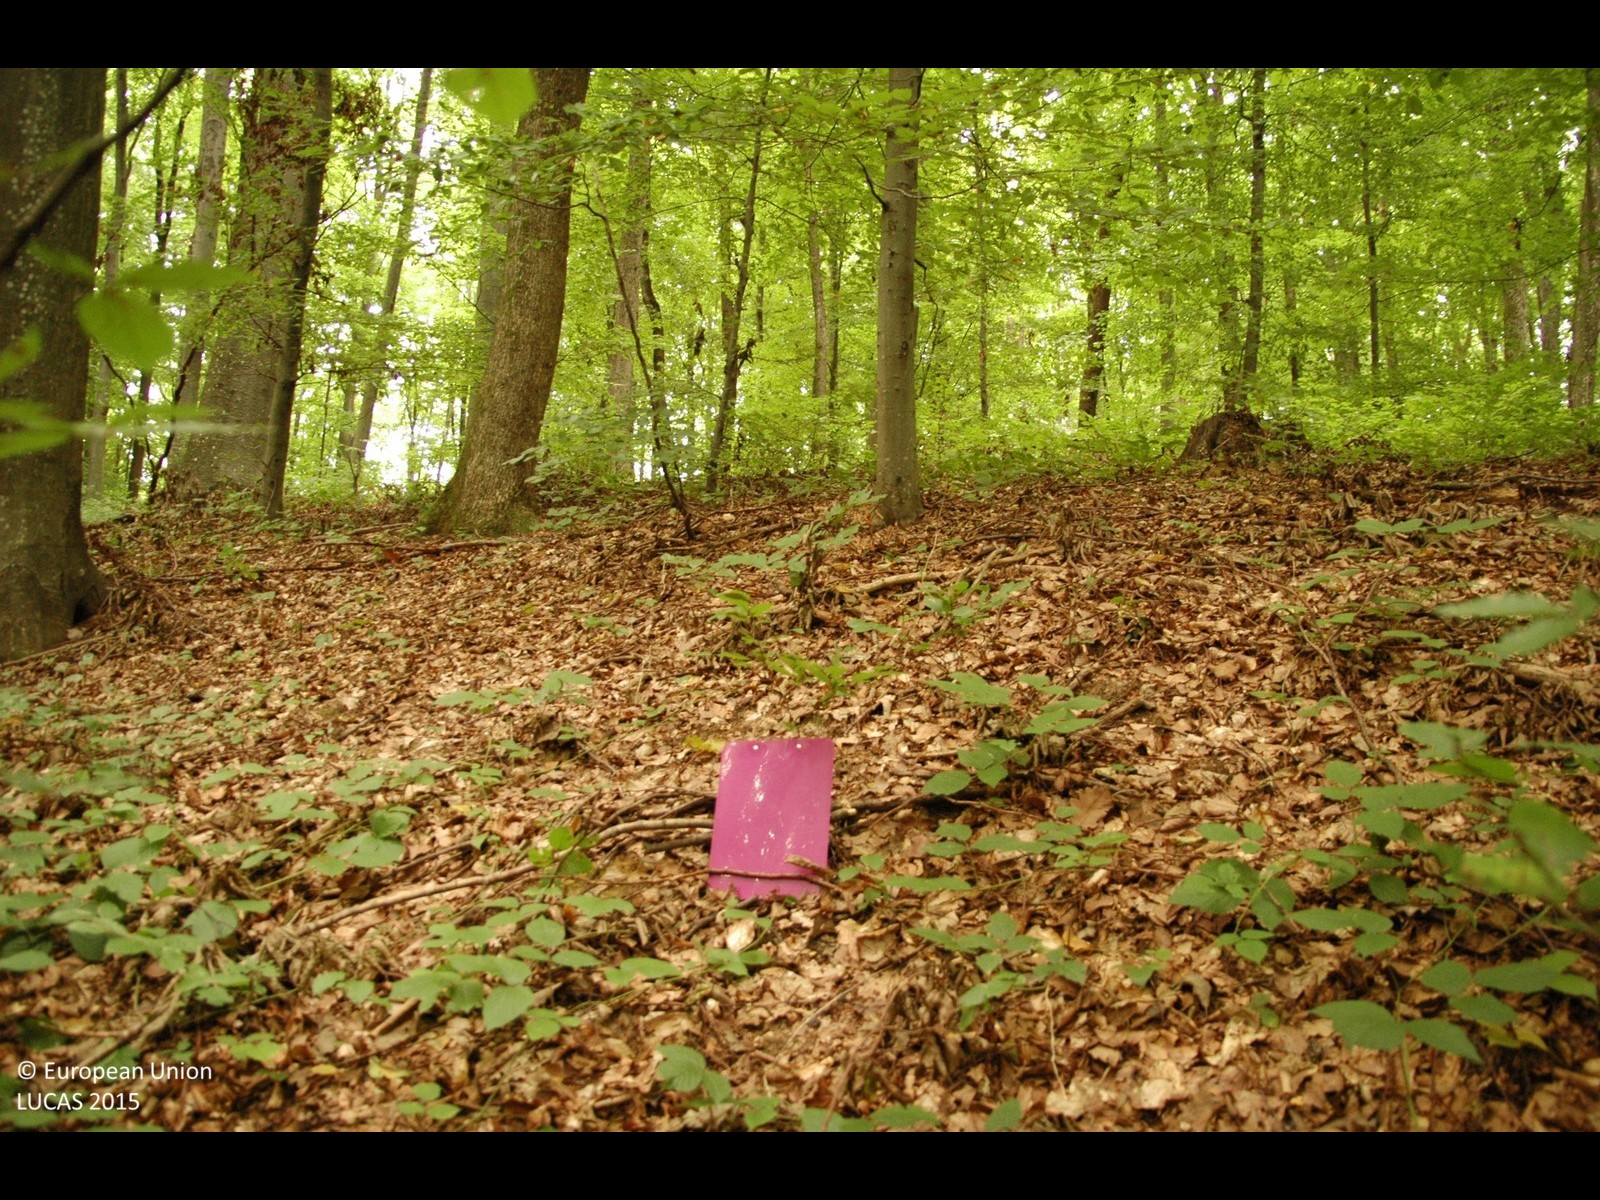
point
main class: Woodland
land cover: Broadleaved woodland
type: beech forest
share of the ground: > 75 %
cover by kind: broadleaved forest trees 100 %
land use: Forestry
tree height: > 5 m
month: September
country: HR
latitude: 46.0877
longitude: 16.6868
